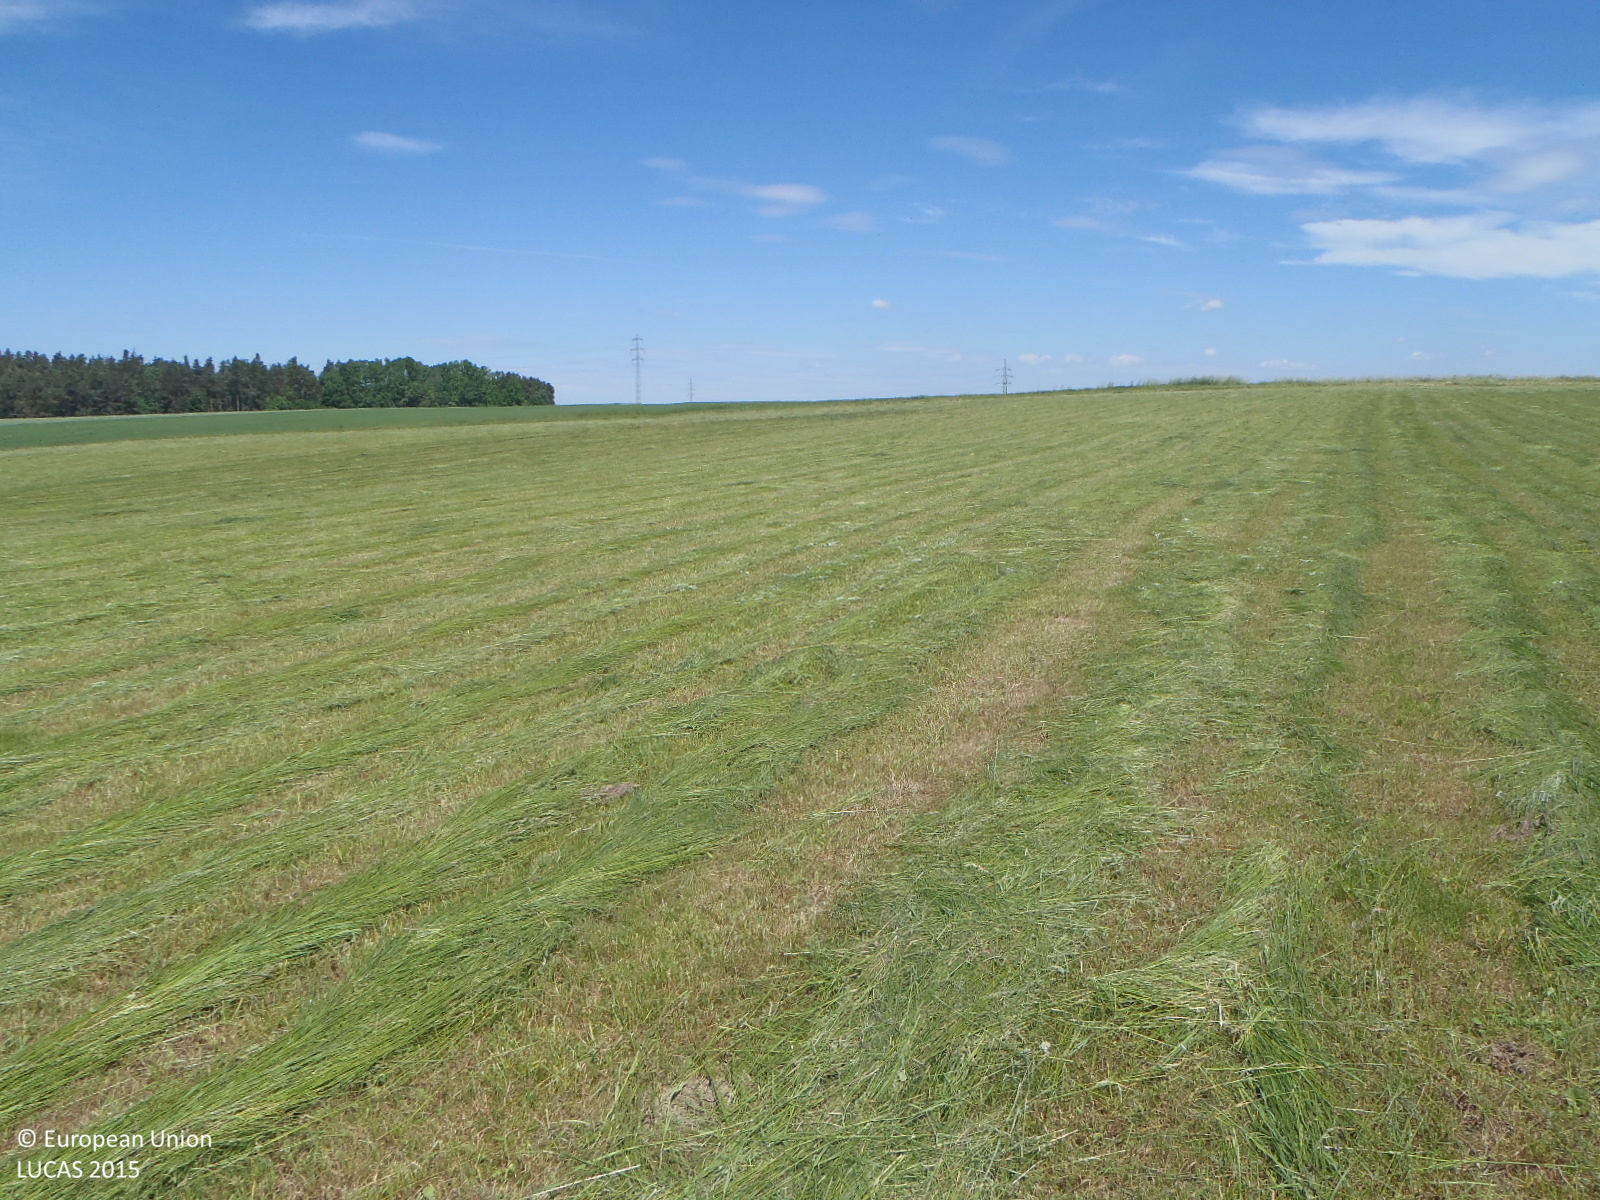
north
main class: Grassland
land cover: Grassland without tree/shrub cover
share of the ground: > 75 %
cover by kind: herbaceous plants 100 %
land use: Agriculture (excluding fallow land and kitchen gardens)
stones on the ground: < 10 %
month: June
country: CZ
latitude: 48.8912
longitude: 14.4337
